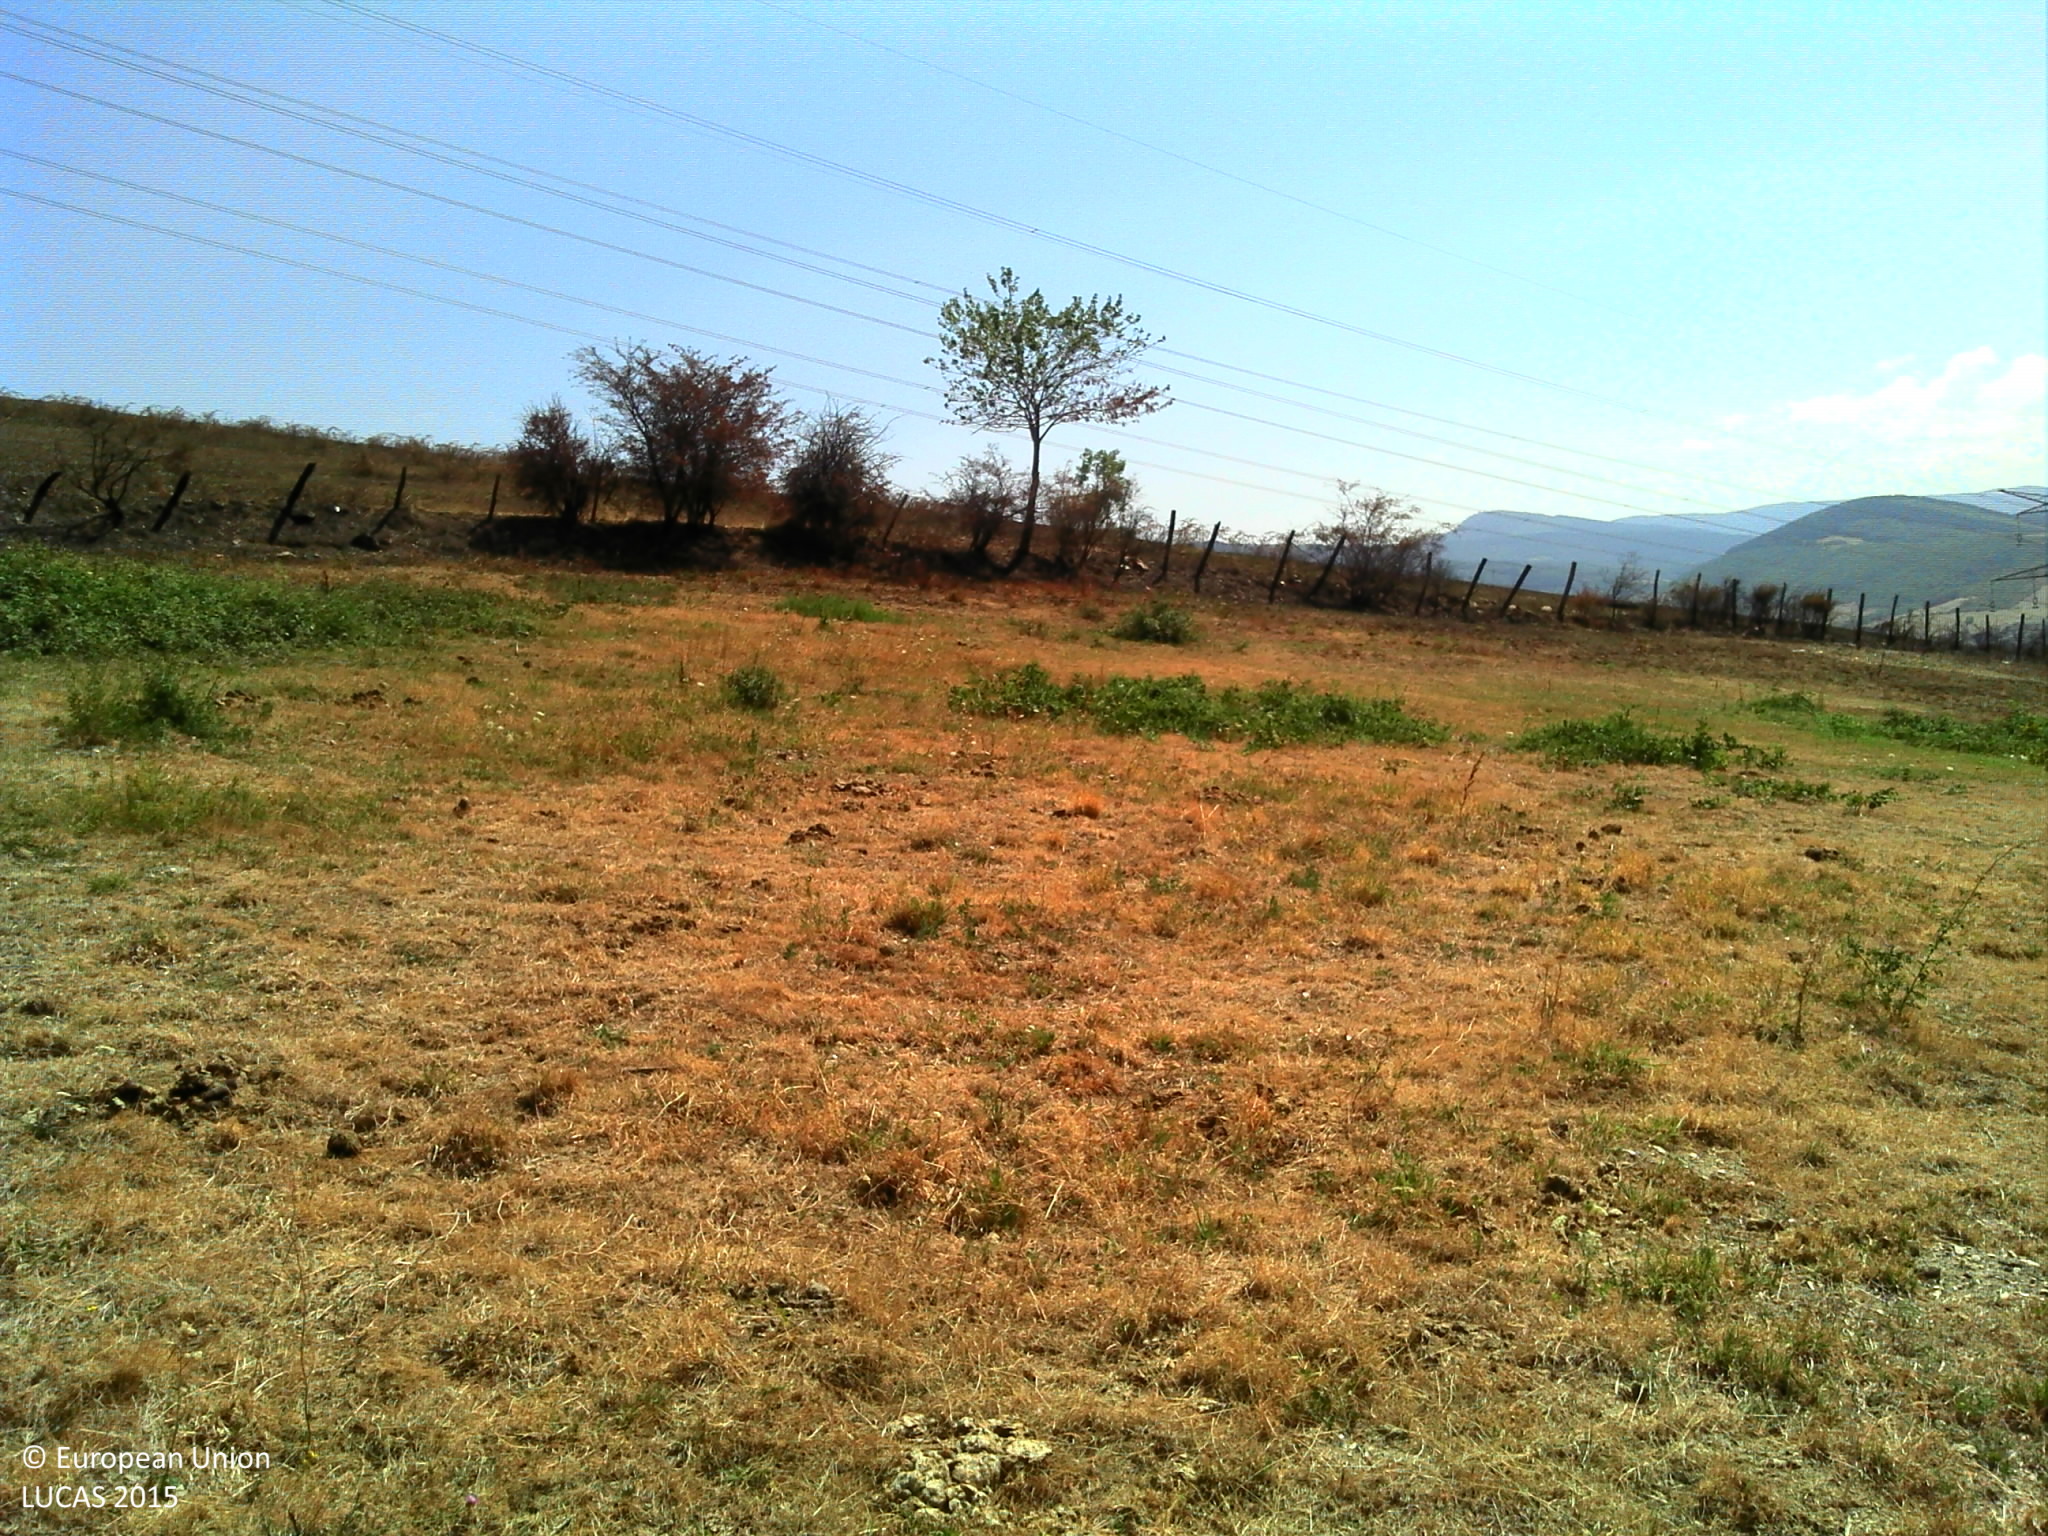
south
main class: Grassland
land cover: Grassland without tree/shrub cover
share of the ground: > 75 %
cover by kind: herbaceous plants 90 %, unconsolidated bare surface 10 %
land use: Agriculture (excluding fallow land and kitchen gardens)
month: August
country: FR
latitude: 45.5128
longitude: 4.6405
